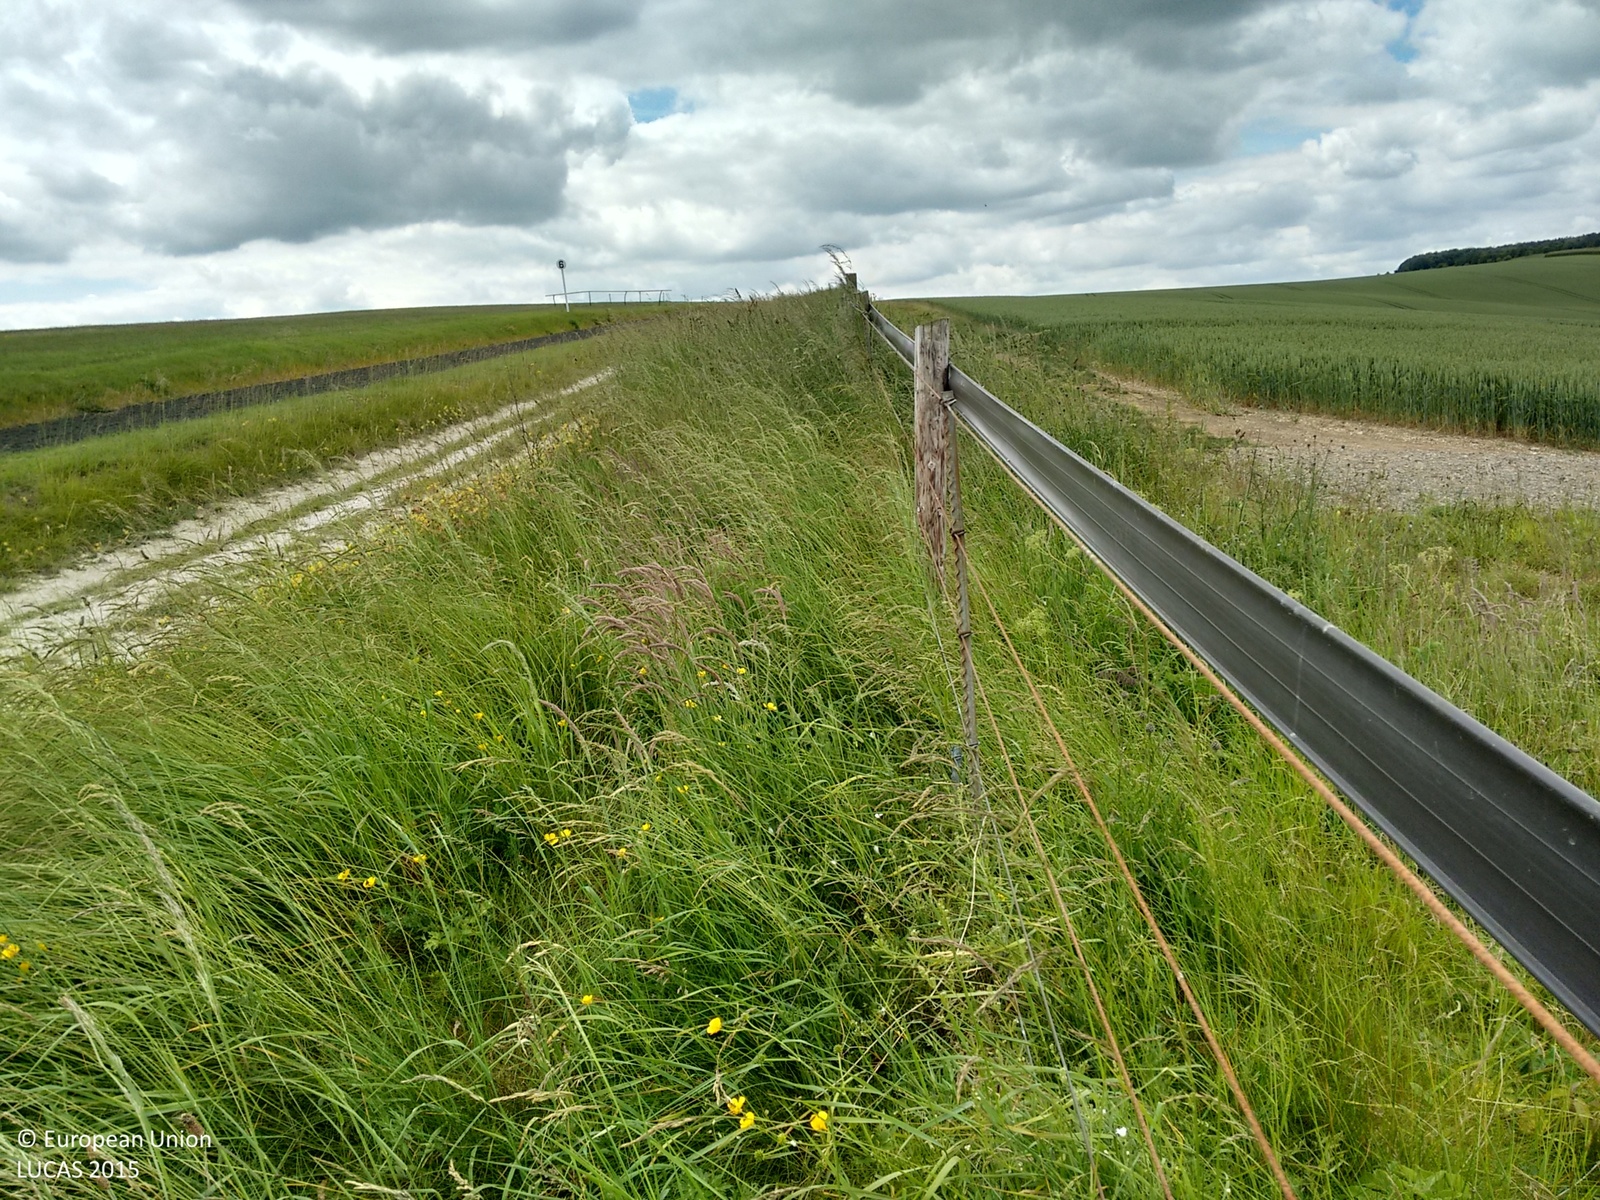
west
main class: Cropland
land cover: Common wheat
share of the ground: > 75 %
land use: Agriculture (excluding fallow land and kitchen gardens)
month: June
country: GB
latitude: 51.5574
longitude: -1.5475
